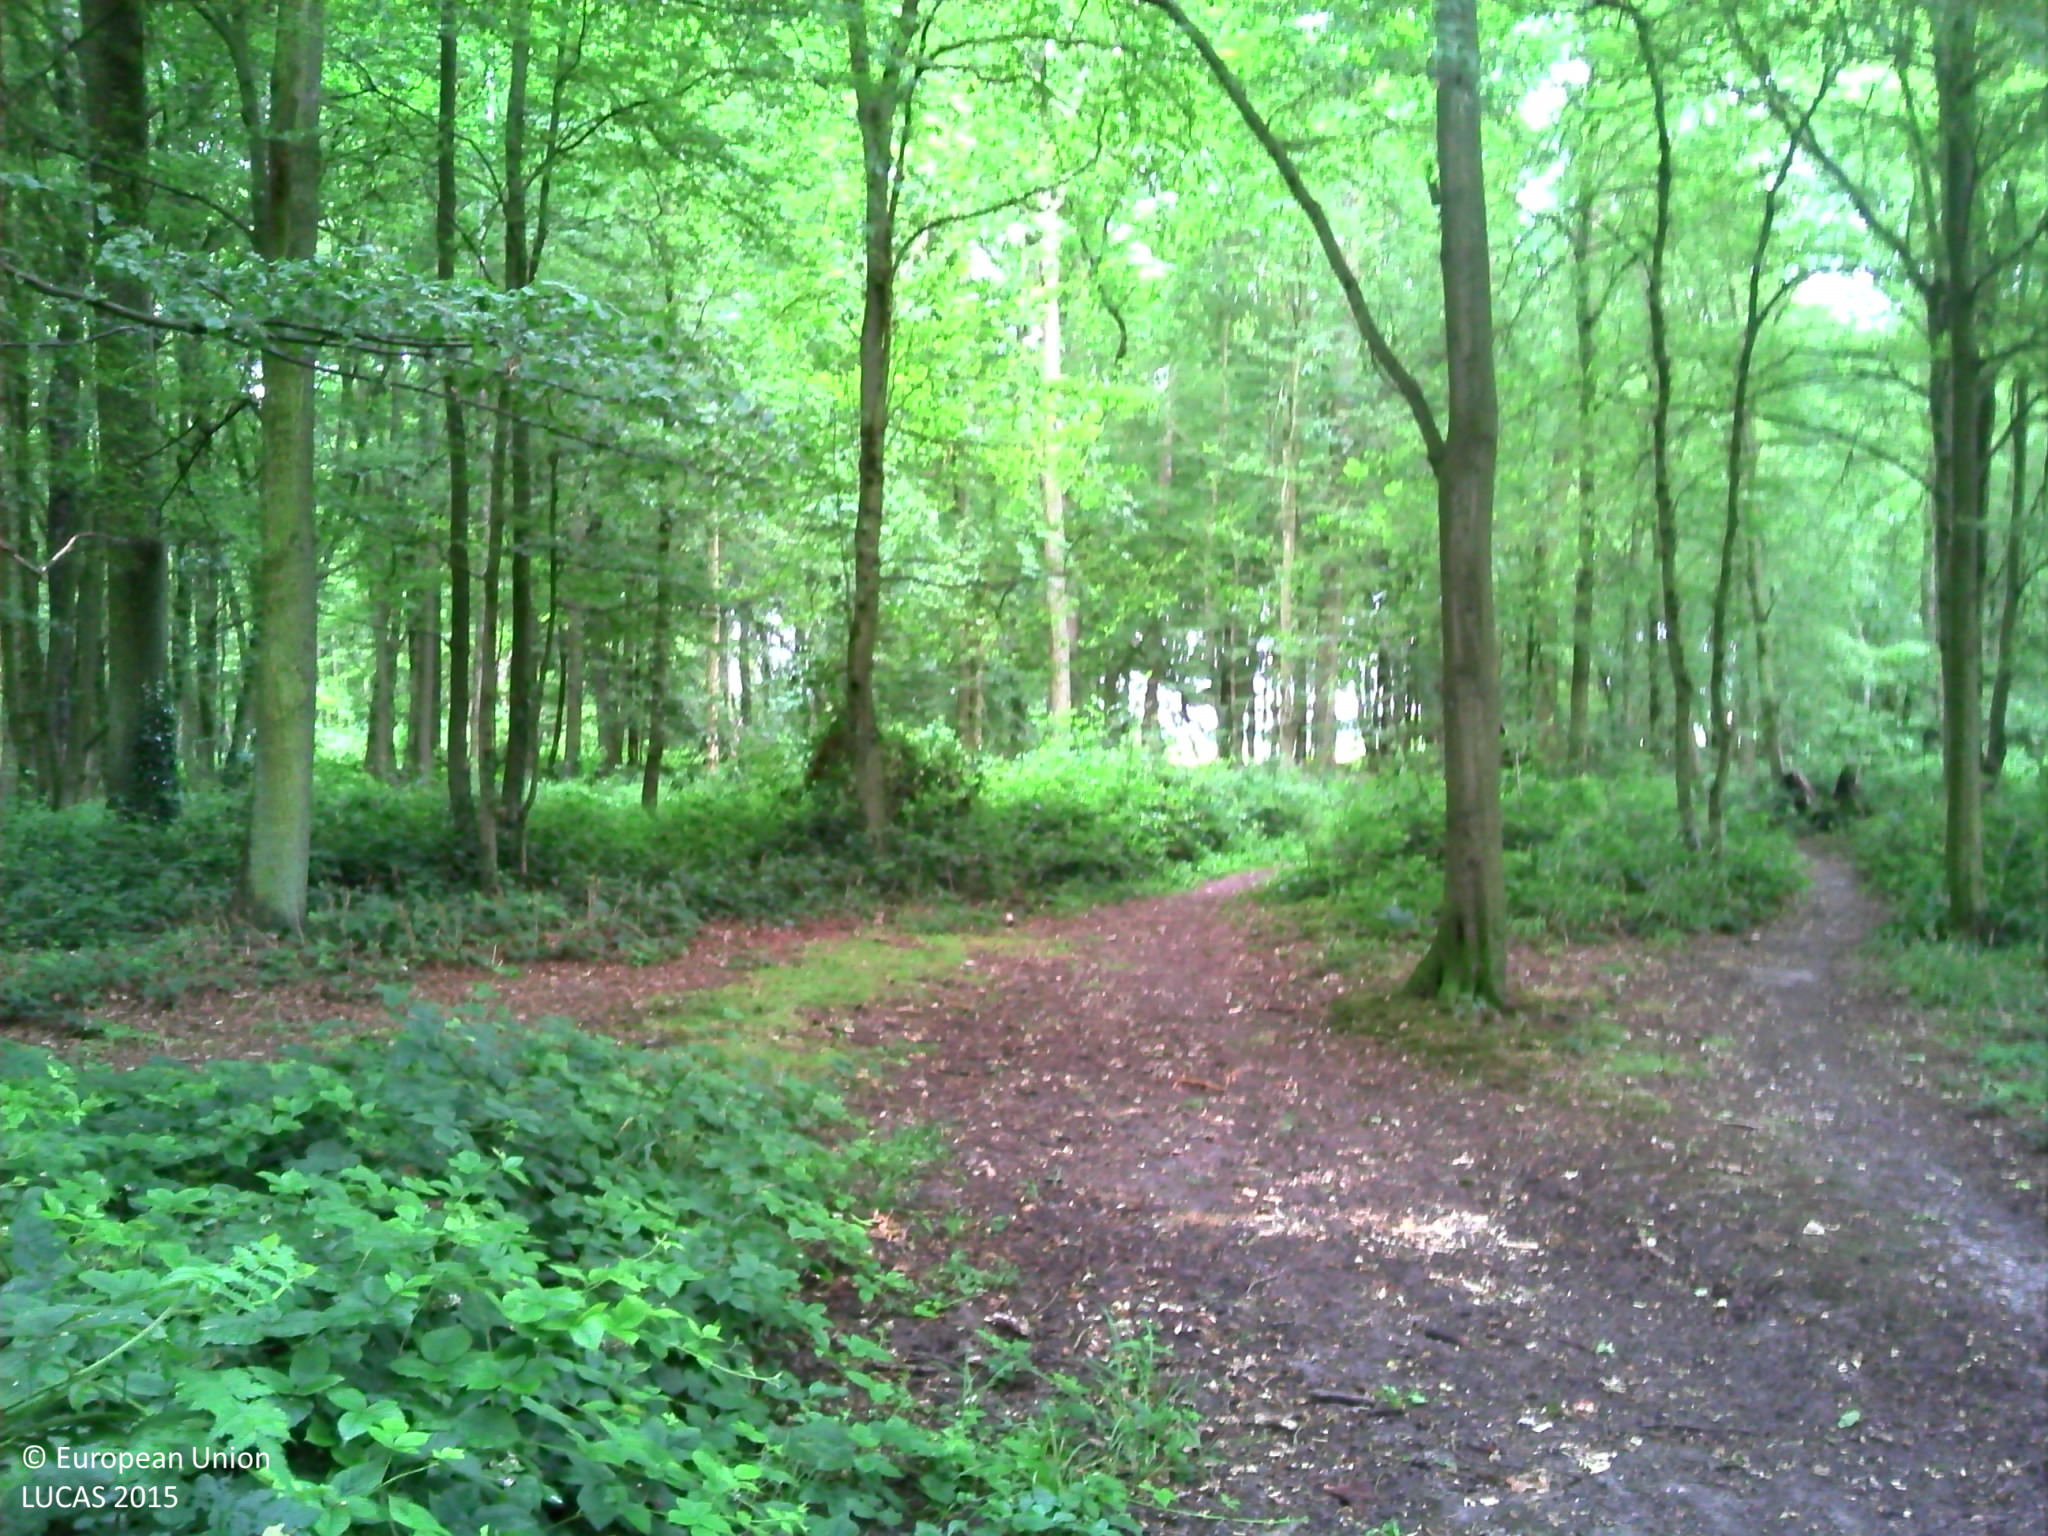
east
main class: Woodland
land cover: Broadleaved woodland
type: acidophilous oak and oak-birch forest
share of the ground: > 75 %
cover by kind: broadleaved forest trees 80 %, herbaceous plants 15 %, lichens and mosses 5 %
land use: Forestry
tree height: > 5 m
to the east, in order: Broadleaved woodland; Tracks; Broadleaved woodland; Ditches and canals; Paved roads, cycling and walking lanes; Ditches and canals; Grass margins; Common wheat
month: July
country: FR
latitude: 50.4966
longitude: 3.0686
